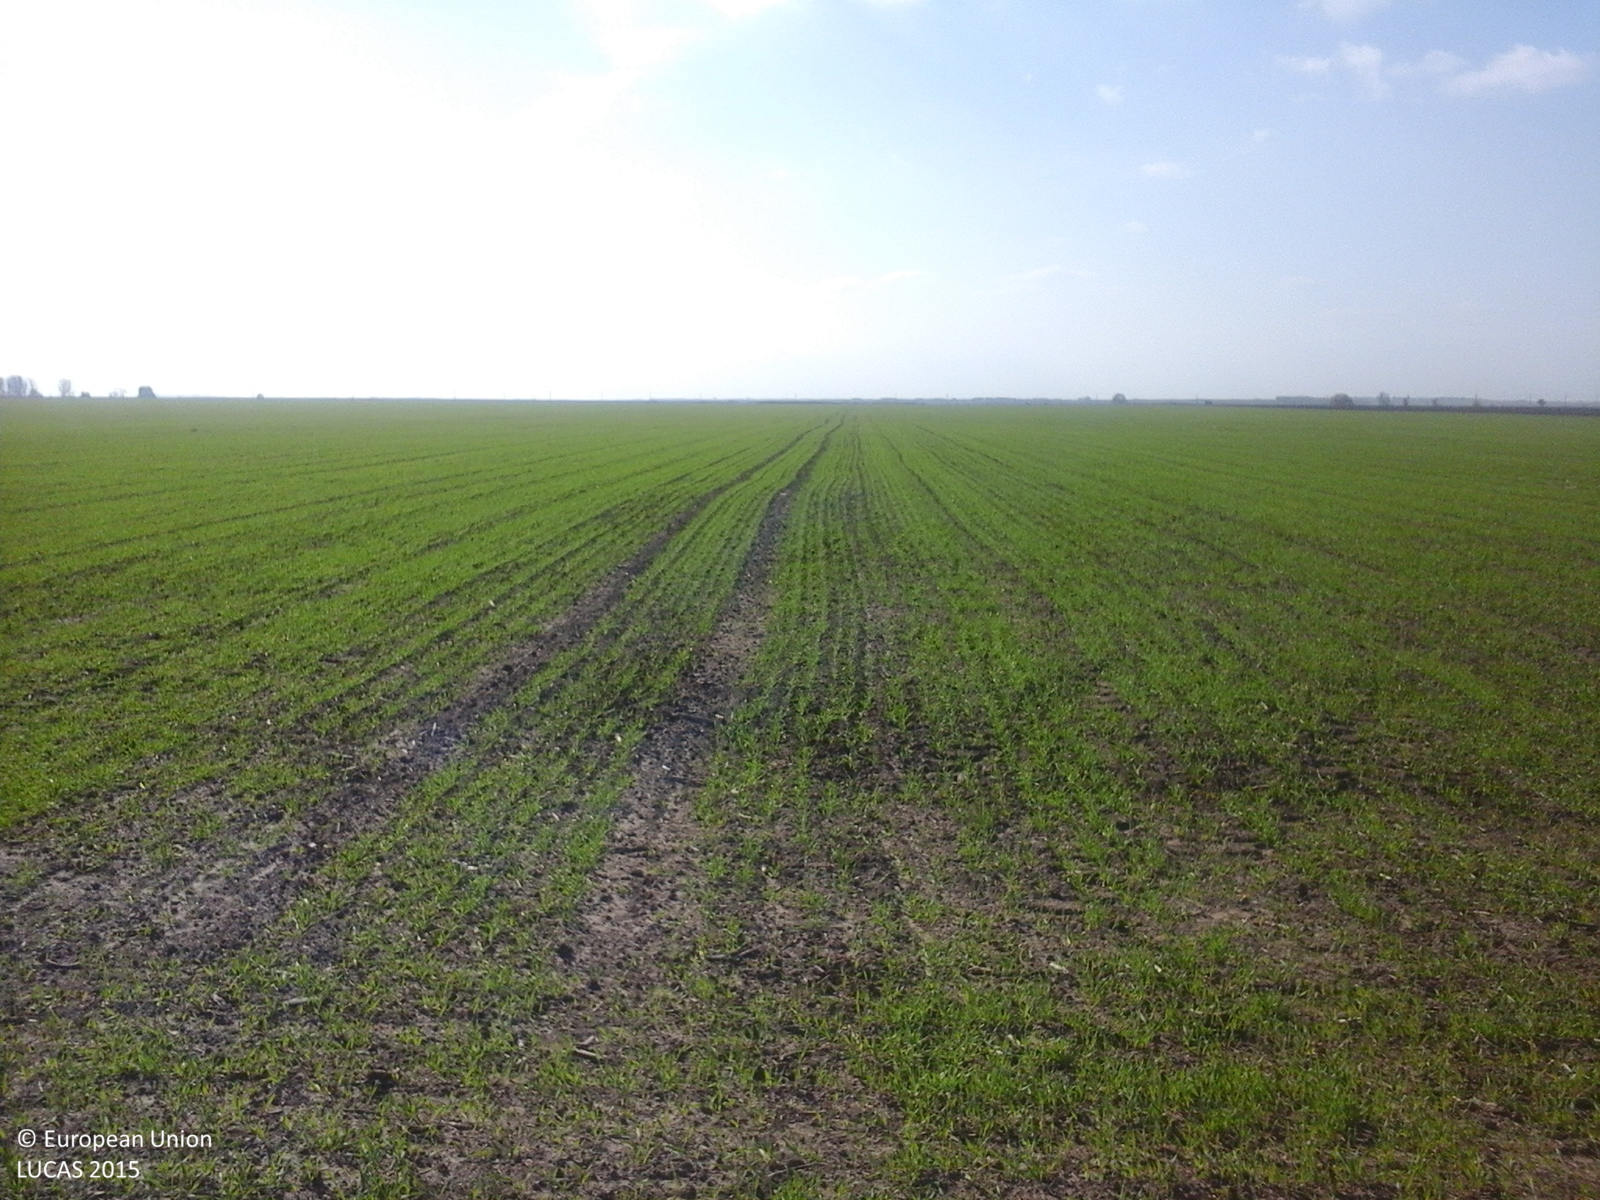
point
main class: Cropland
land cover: Common wheat
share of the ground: 25 - 50 %
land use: Agriculture (excluding fallow land and kitchen gardens)
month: October
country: RO
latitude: 45.3055
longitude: 27.3521
